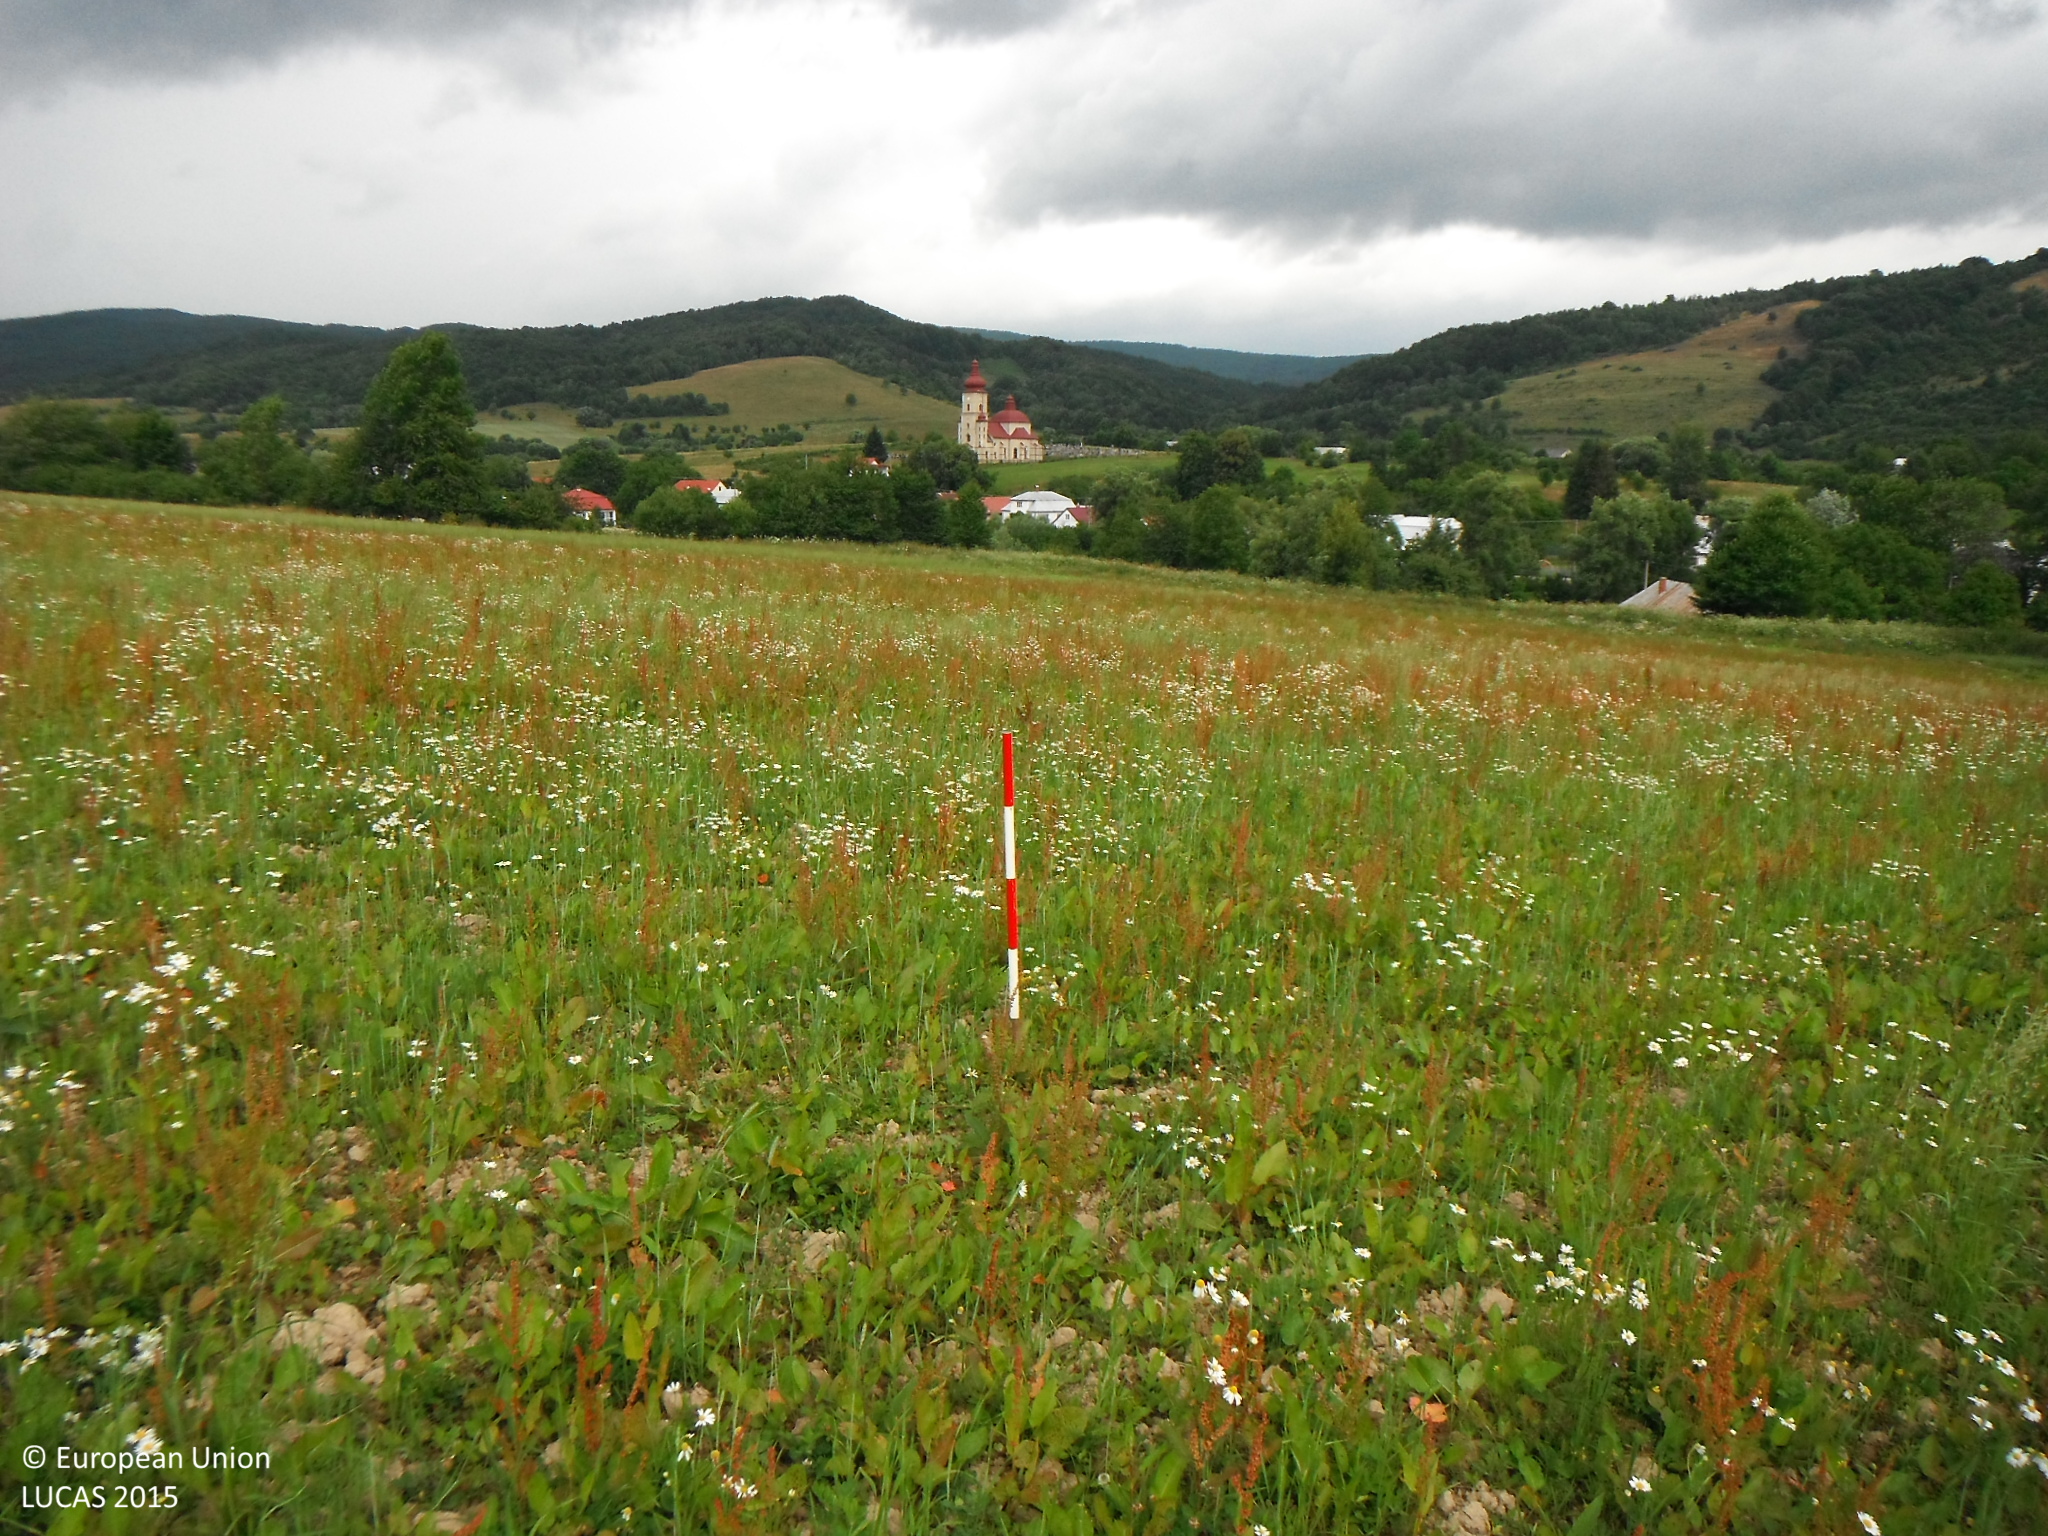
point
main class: Grassland
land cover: Spontaneously vegetated surfaces
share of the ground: > 75 %
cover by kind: herbaceous plants 90 %, unconsolidated bare surface 10 %
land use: Fallow land
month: July
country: SK
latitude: 49.3484
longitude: 21.8231
